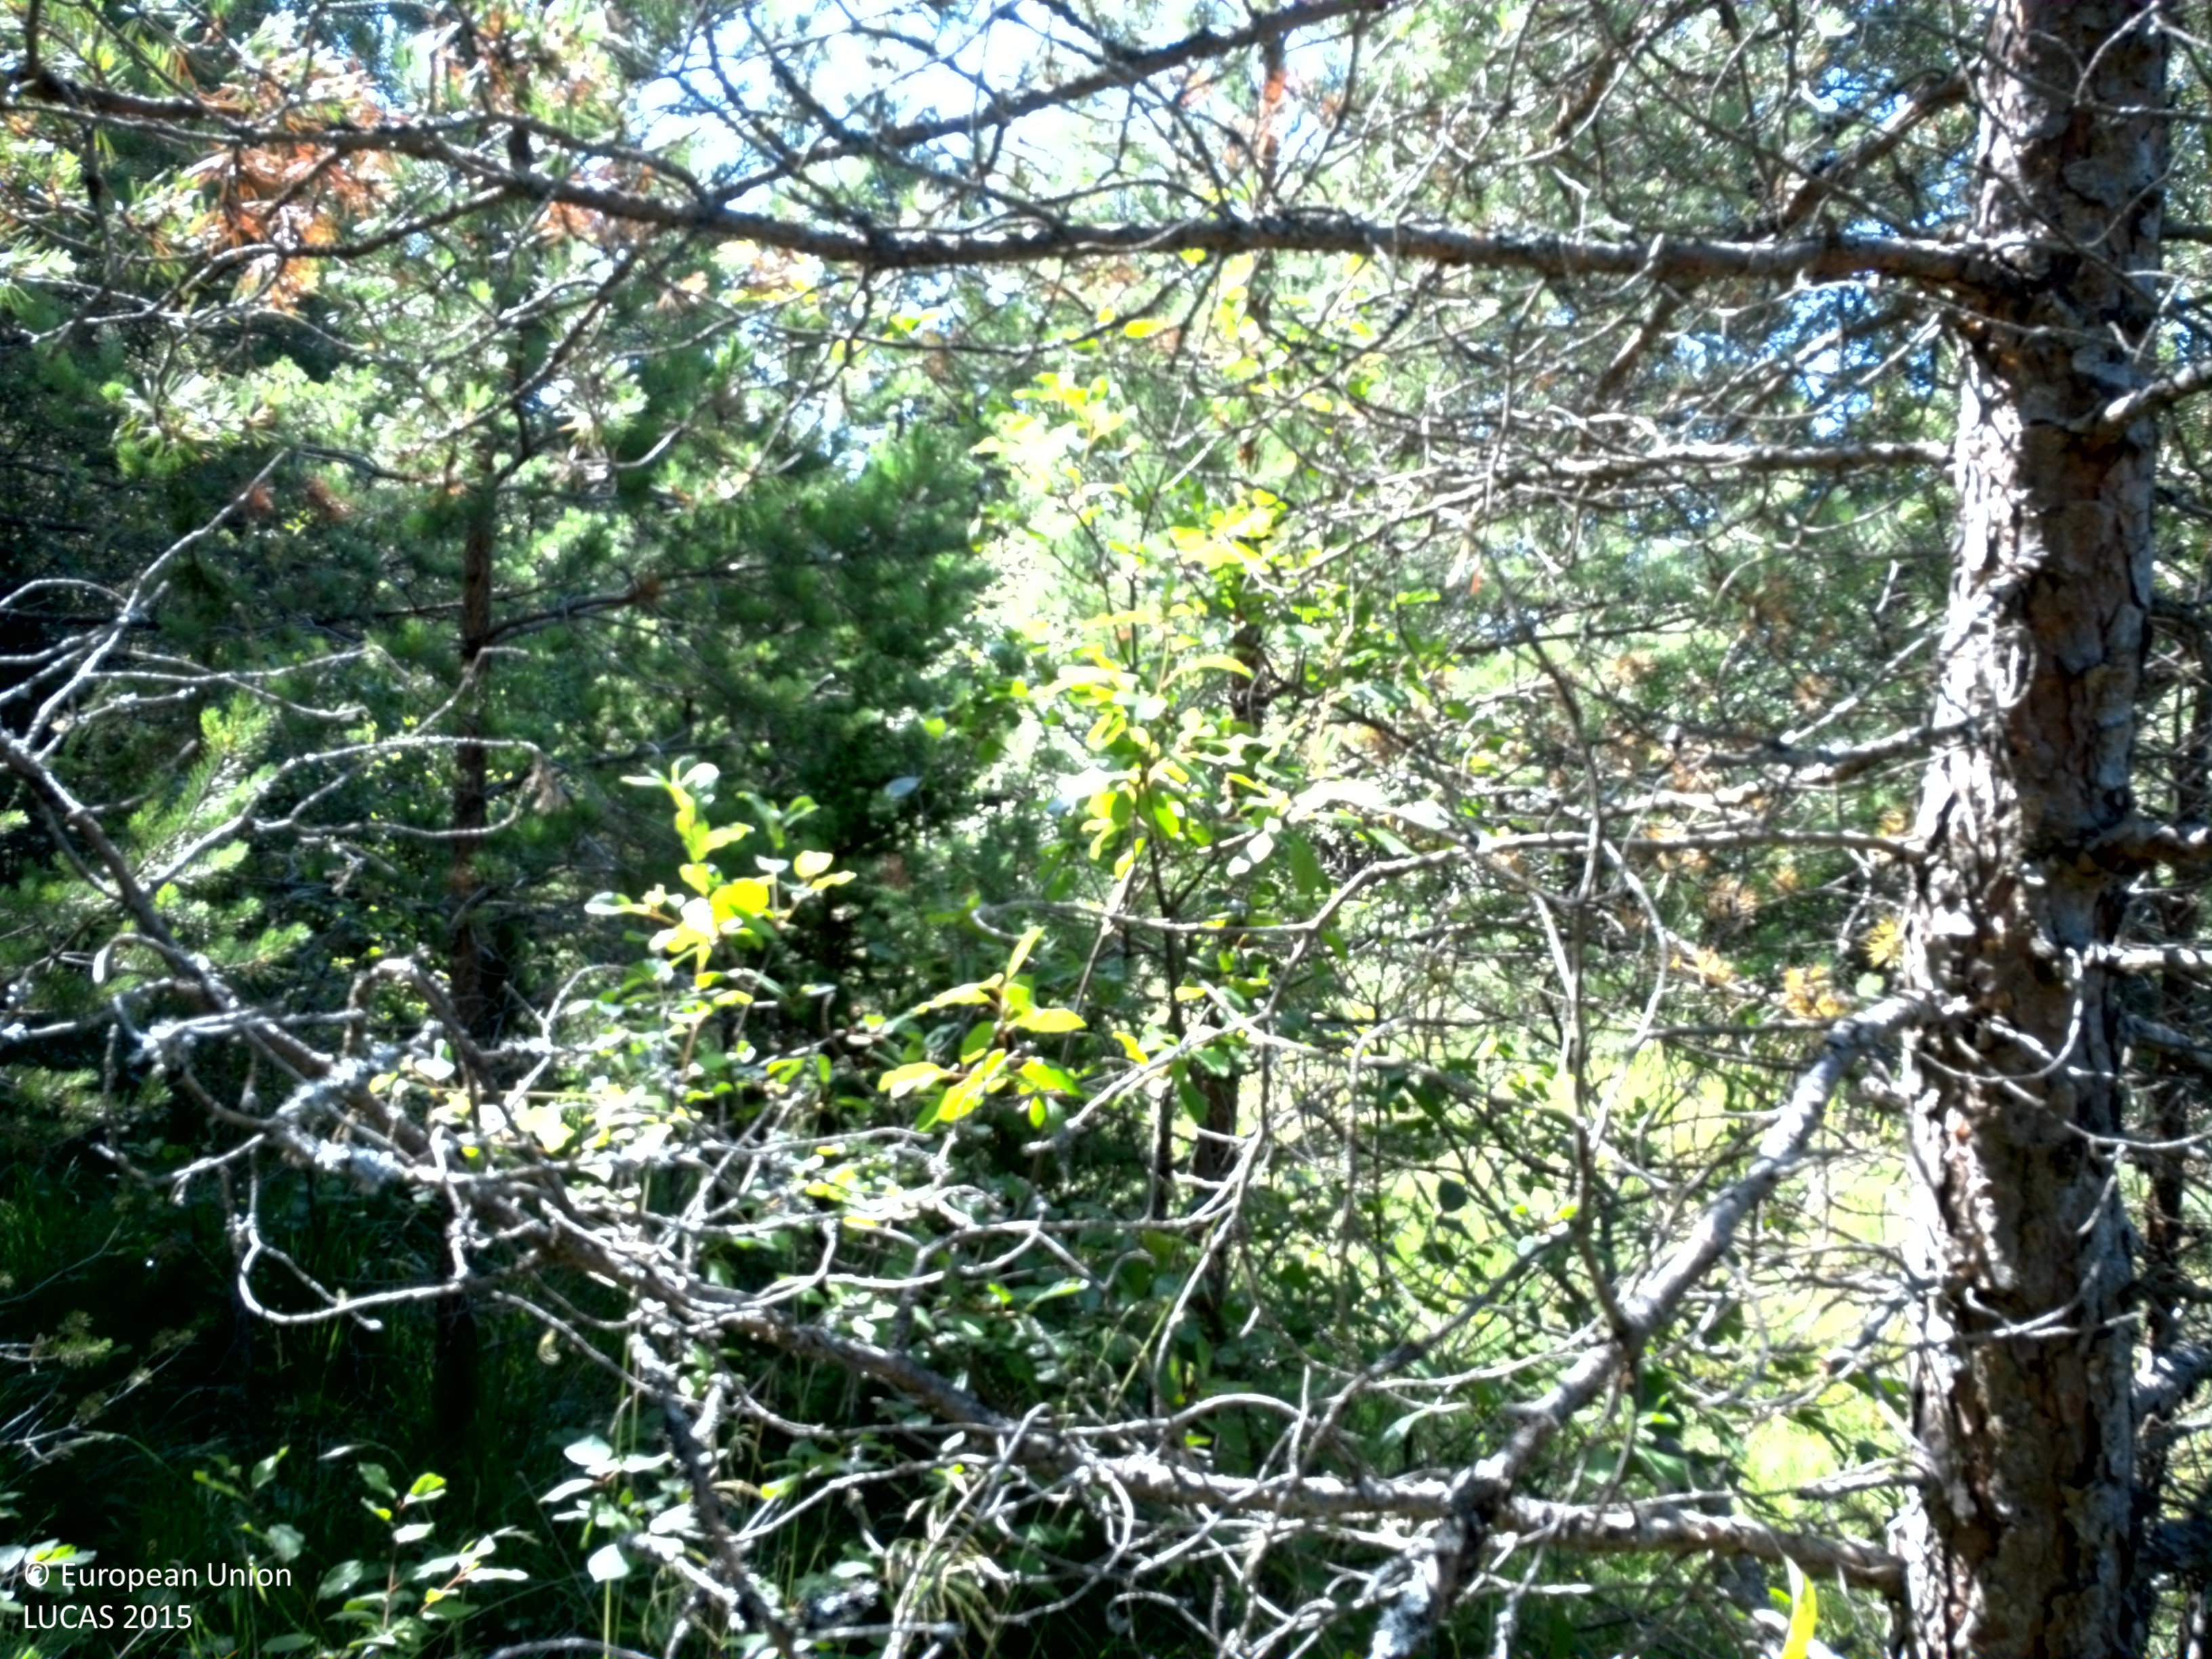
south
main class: Woodland
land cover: Pine dominated mixed woodland
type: hemiboreal forest and nemoral coniferous forest and mixed broadleaved-coniferous forest
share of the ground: > 75 %
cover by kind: coniferous forest trees 55 %, broadleaved forest trees 20 %, herbaceous plants 15 %, shrubs 10 %
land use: Forestry
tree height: > 5 m
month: July
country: SE
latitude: 57.2089
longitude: 18.2028
